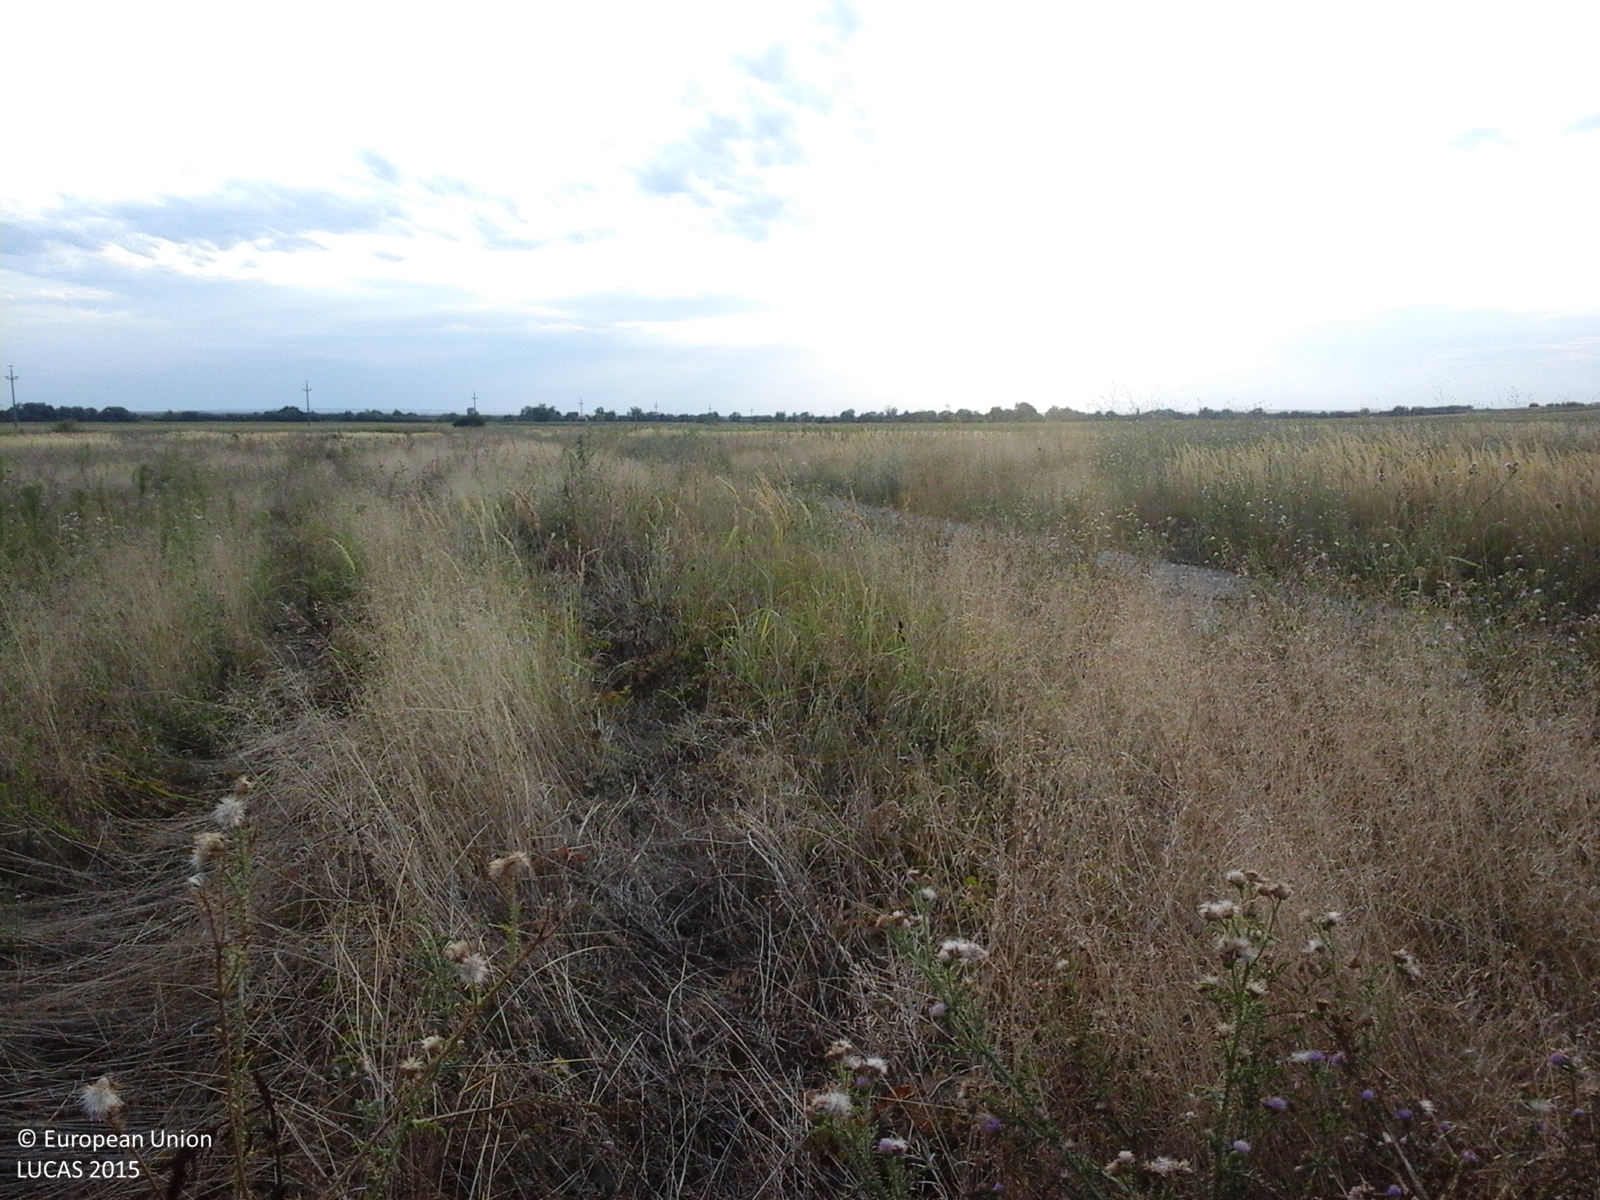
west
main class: Grassland
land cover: Spontaneously vegetated surfaces
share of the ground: > 75 %
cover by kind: herbaceous plants 100 %
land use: Fallow land
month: August
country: RO
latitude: 44.9917
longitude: 21.5853
